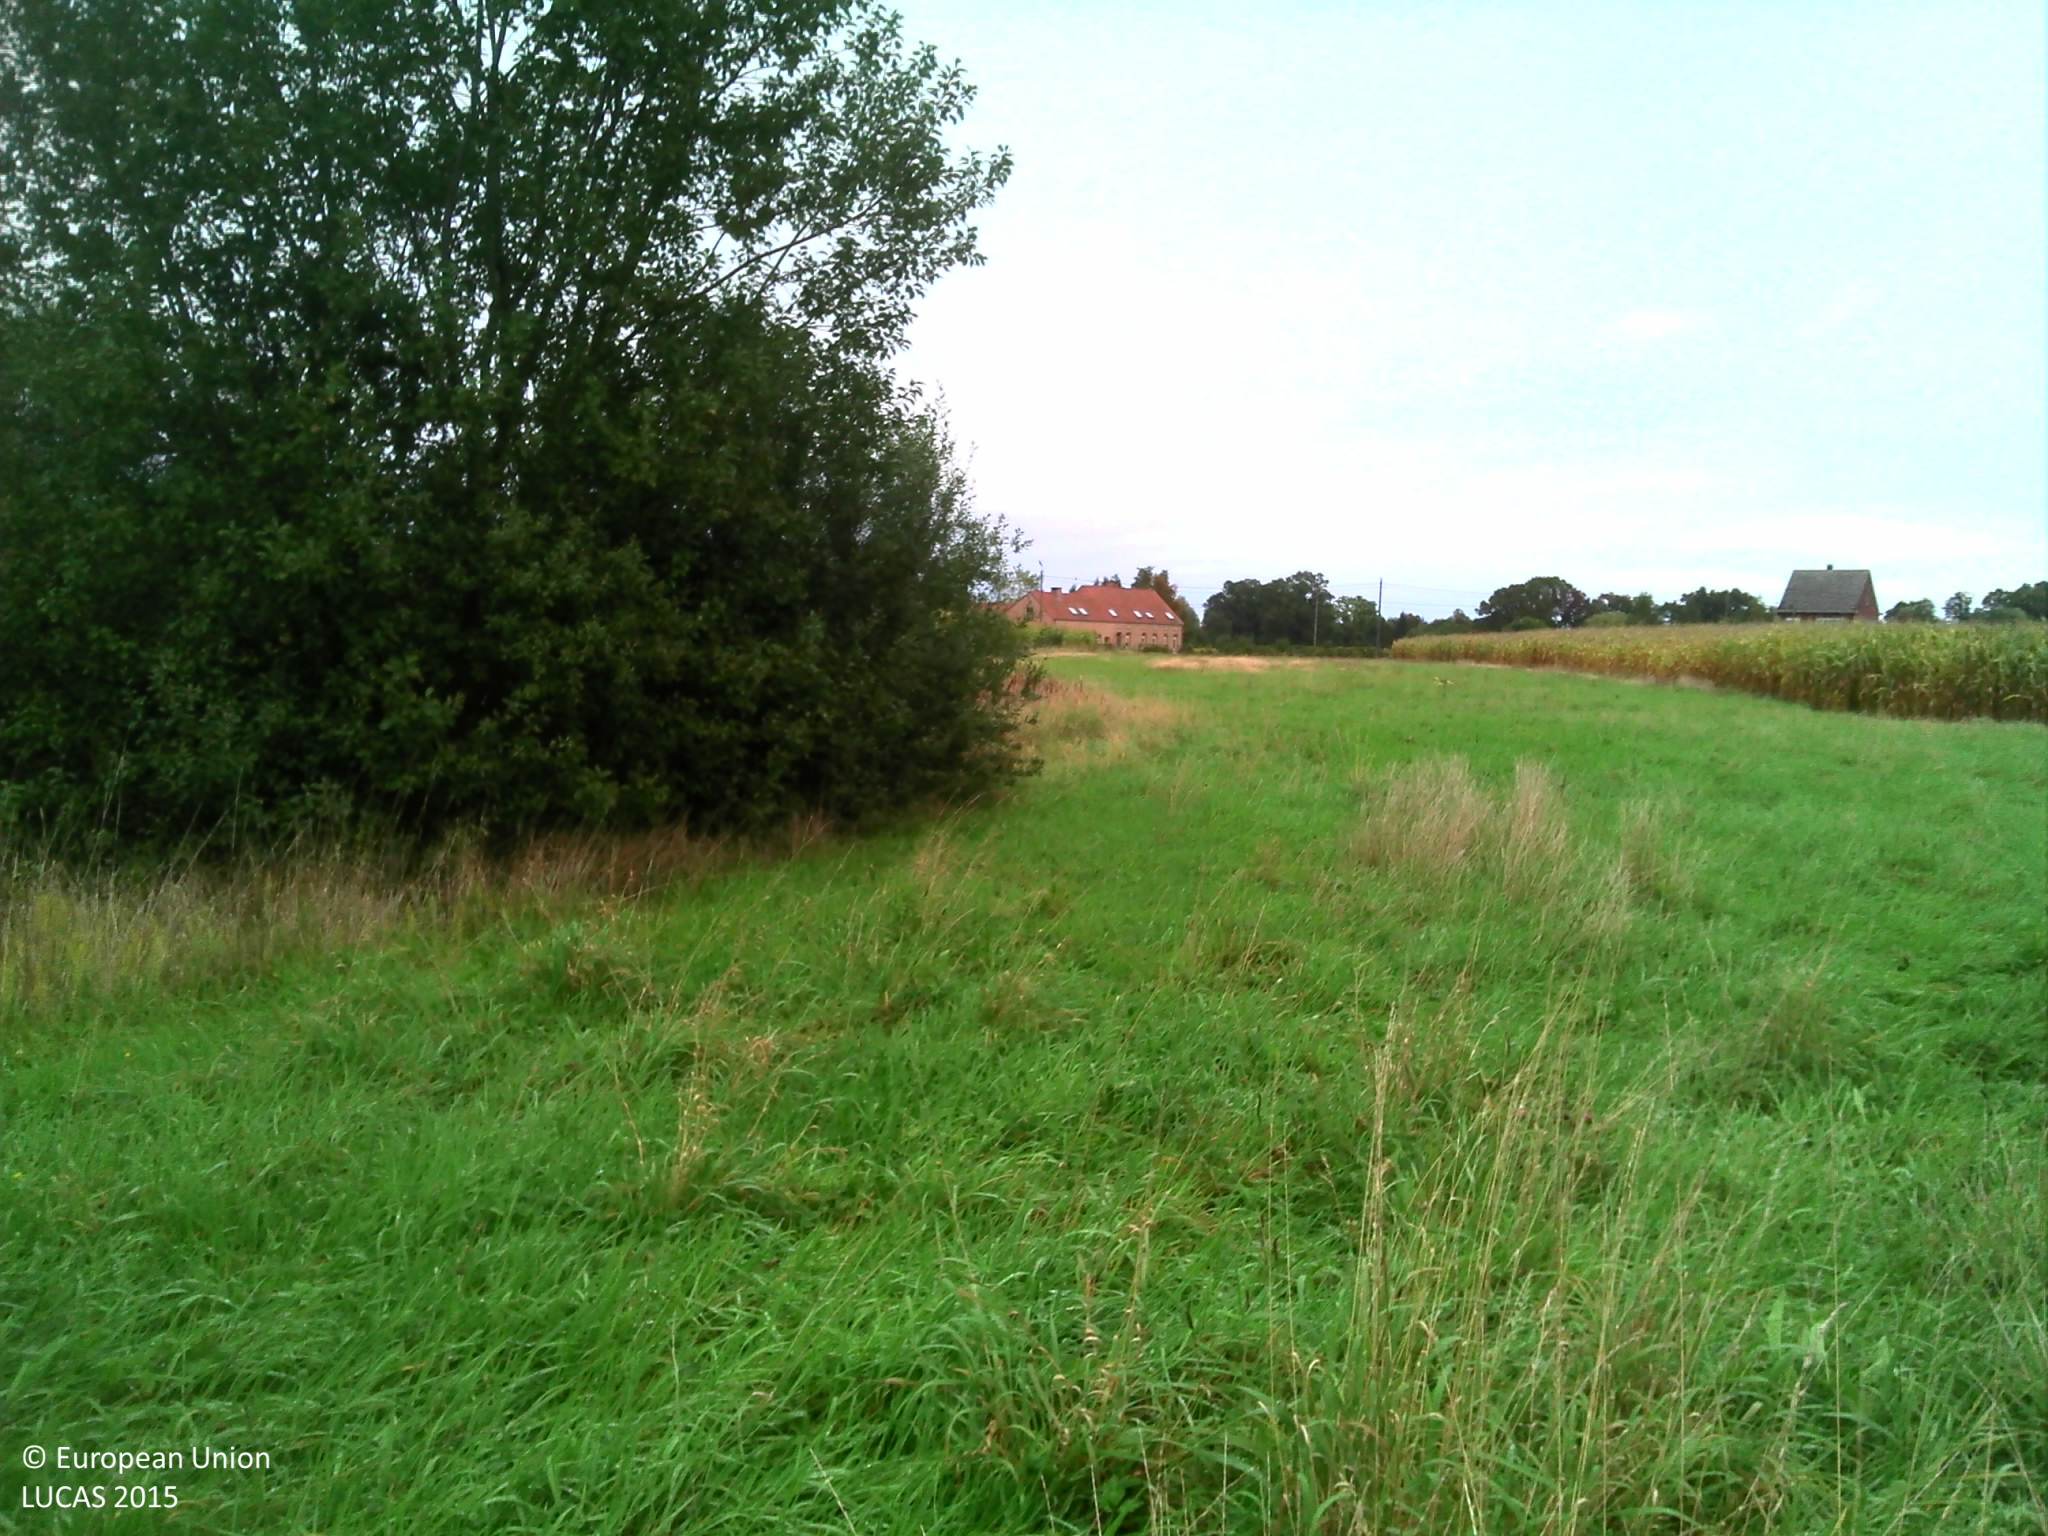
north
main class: Grassland
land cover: Grassland without tree/shrub cover
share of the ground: > 75 %
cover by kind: herbaceous plants 100 %
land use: Agriculture (excluding fallow land and kitchen gardens)
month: October
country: BE
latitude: 51.0549
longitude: 4.7606
